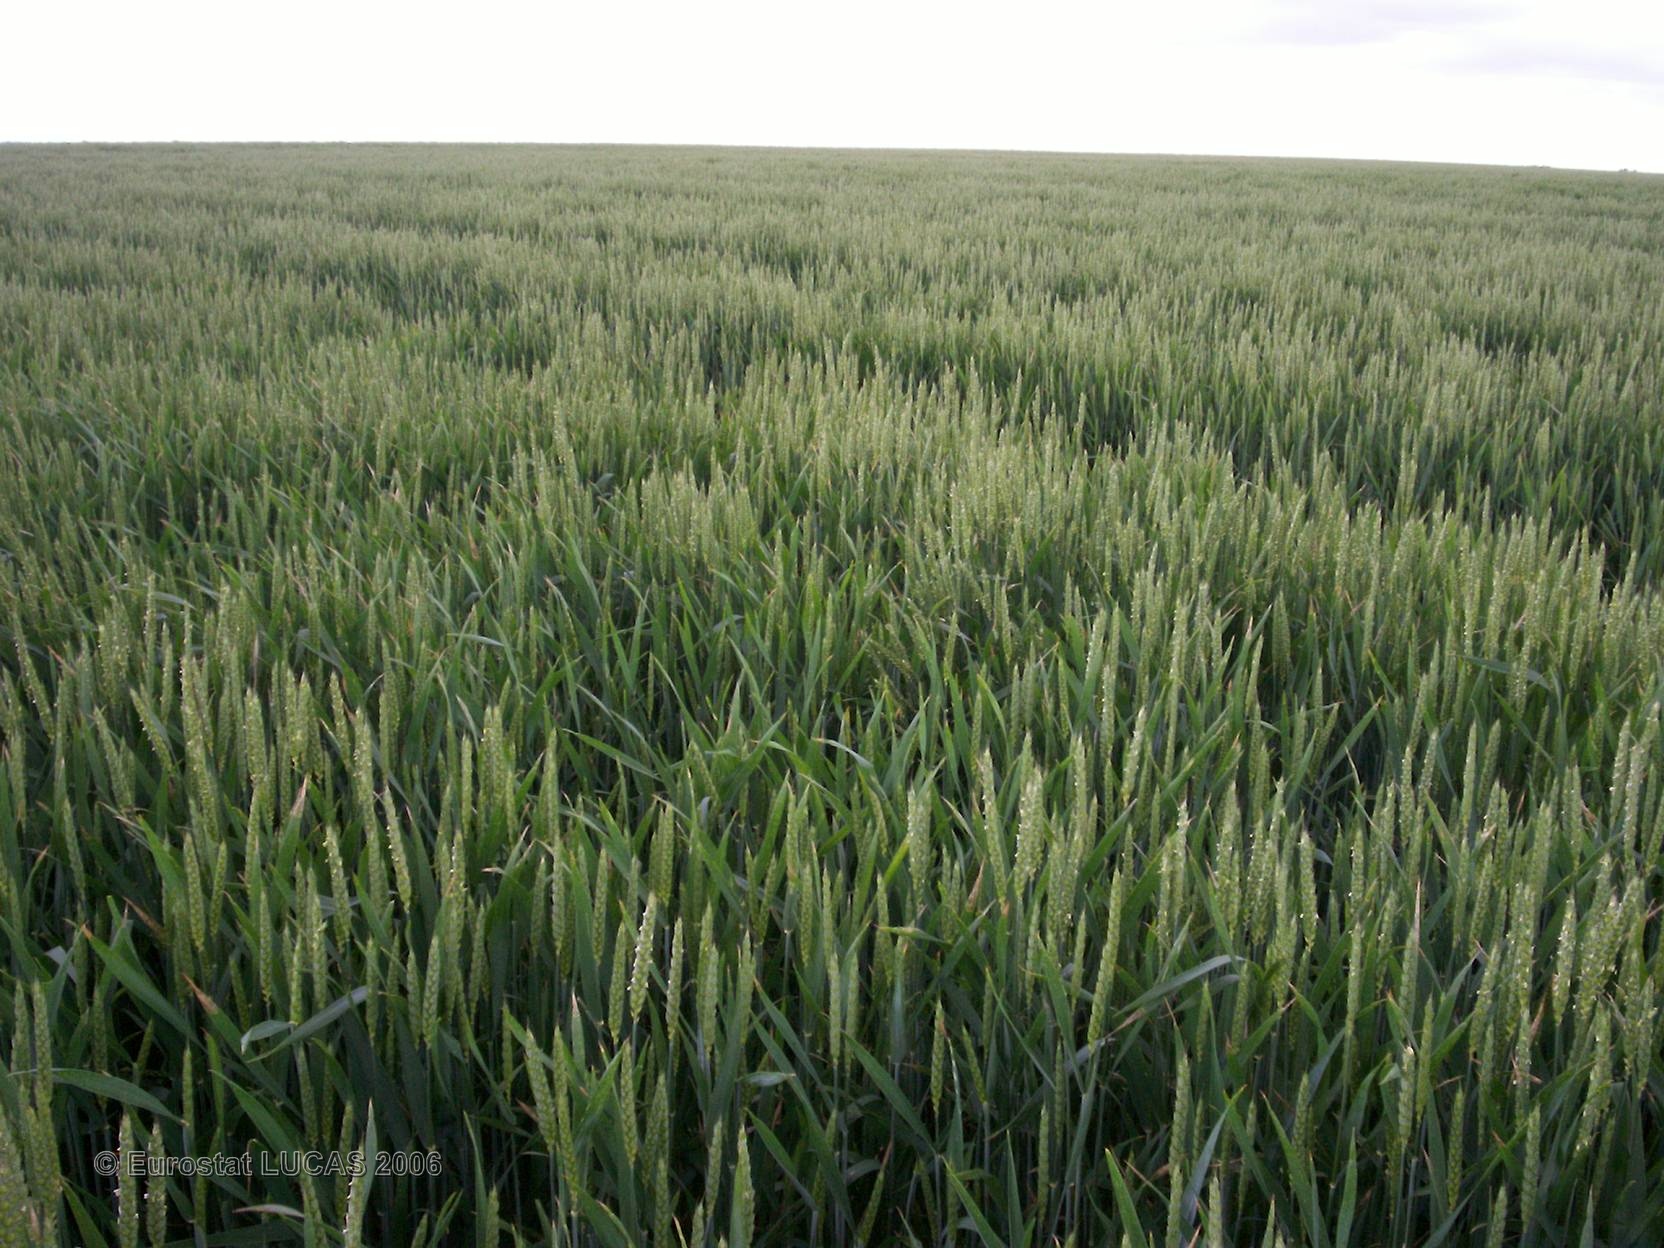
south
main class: Cropland
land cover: Common wheat
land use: Agriculture (excluding fallow land and kitchen gardens)
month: May
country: FR
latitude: 46.8380
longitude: 0.3428
